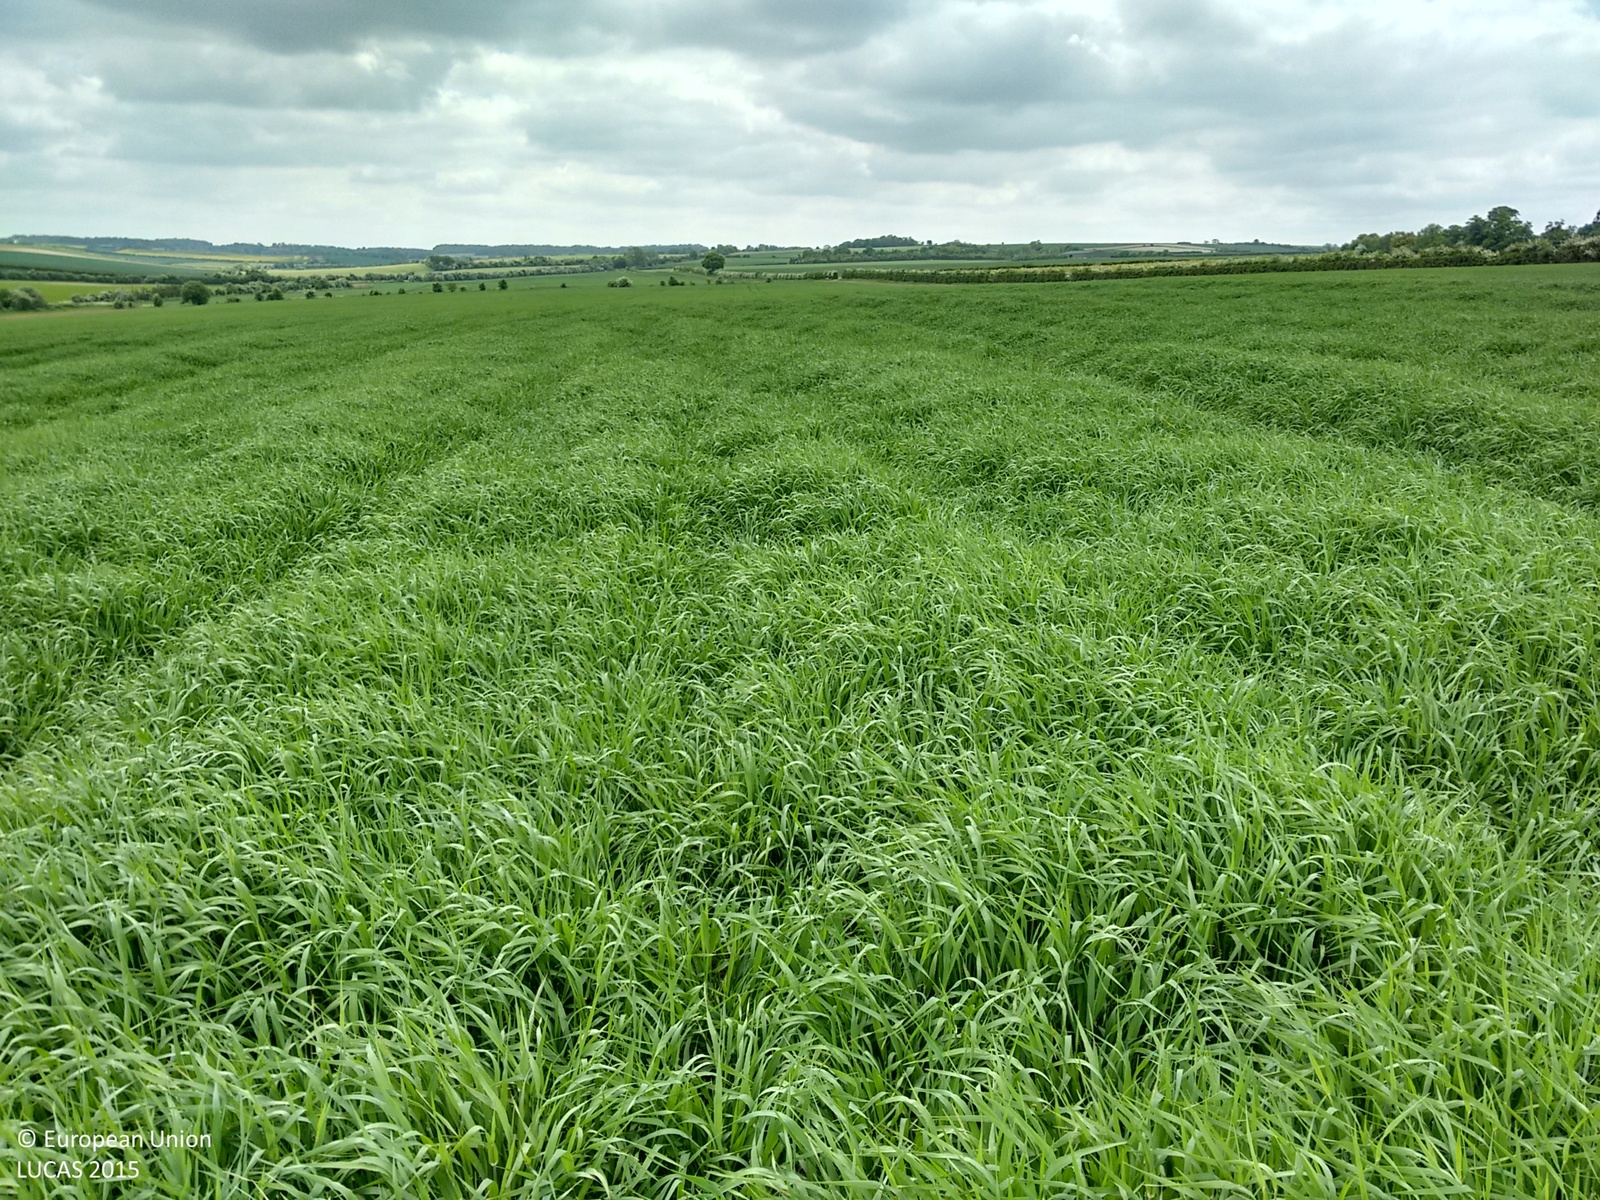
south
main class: Cropland
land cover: Barley
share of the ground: > 75 %
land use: Agriculture (excluding fallow land and kitchen gardens)
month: May
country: GB
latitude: 52.0480
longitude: 0.0377
